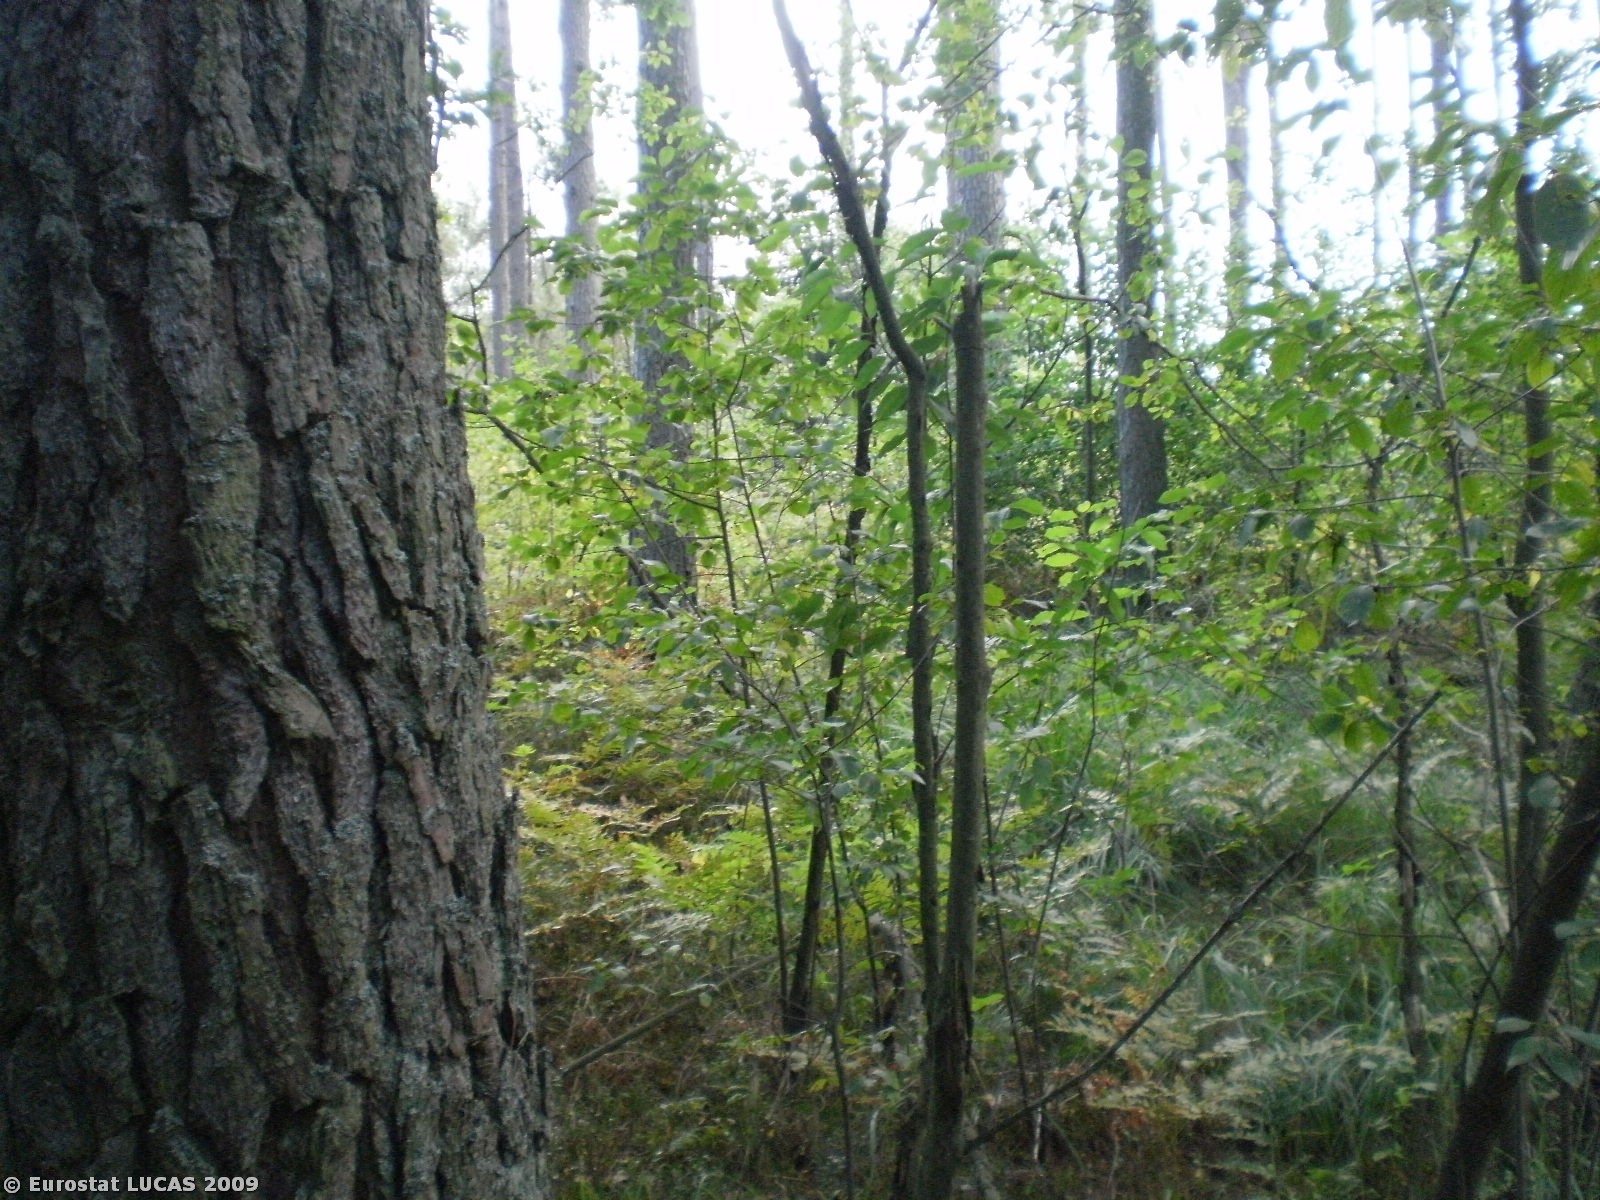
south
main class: Woodland
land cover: Mixed woodland
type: hemiboreal forest and nemoral coniferous forest and mixed broadleaved-coniferous forest
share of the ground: > 75 %
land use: Forestry
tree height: > 5 m
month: August
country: PL
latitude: 52.7672
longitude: 21.8082
